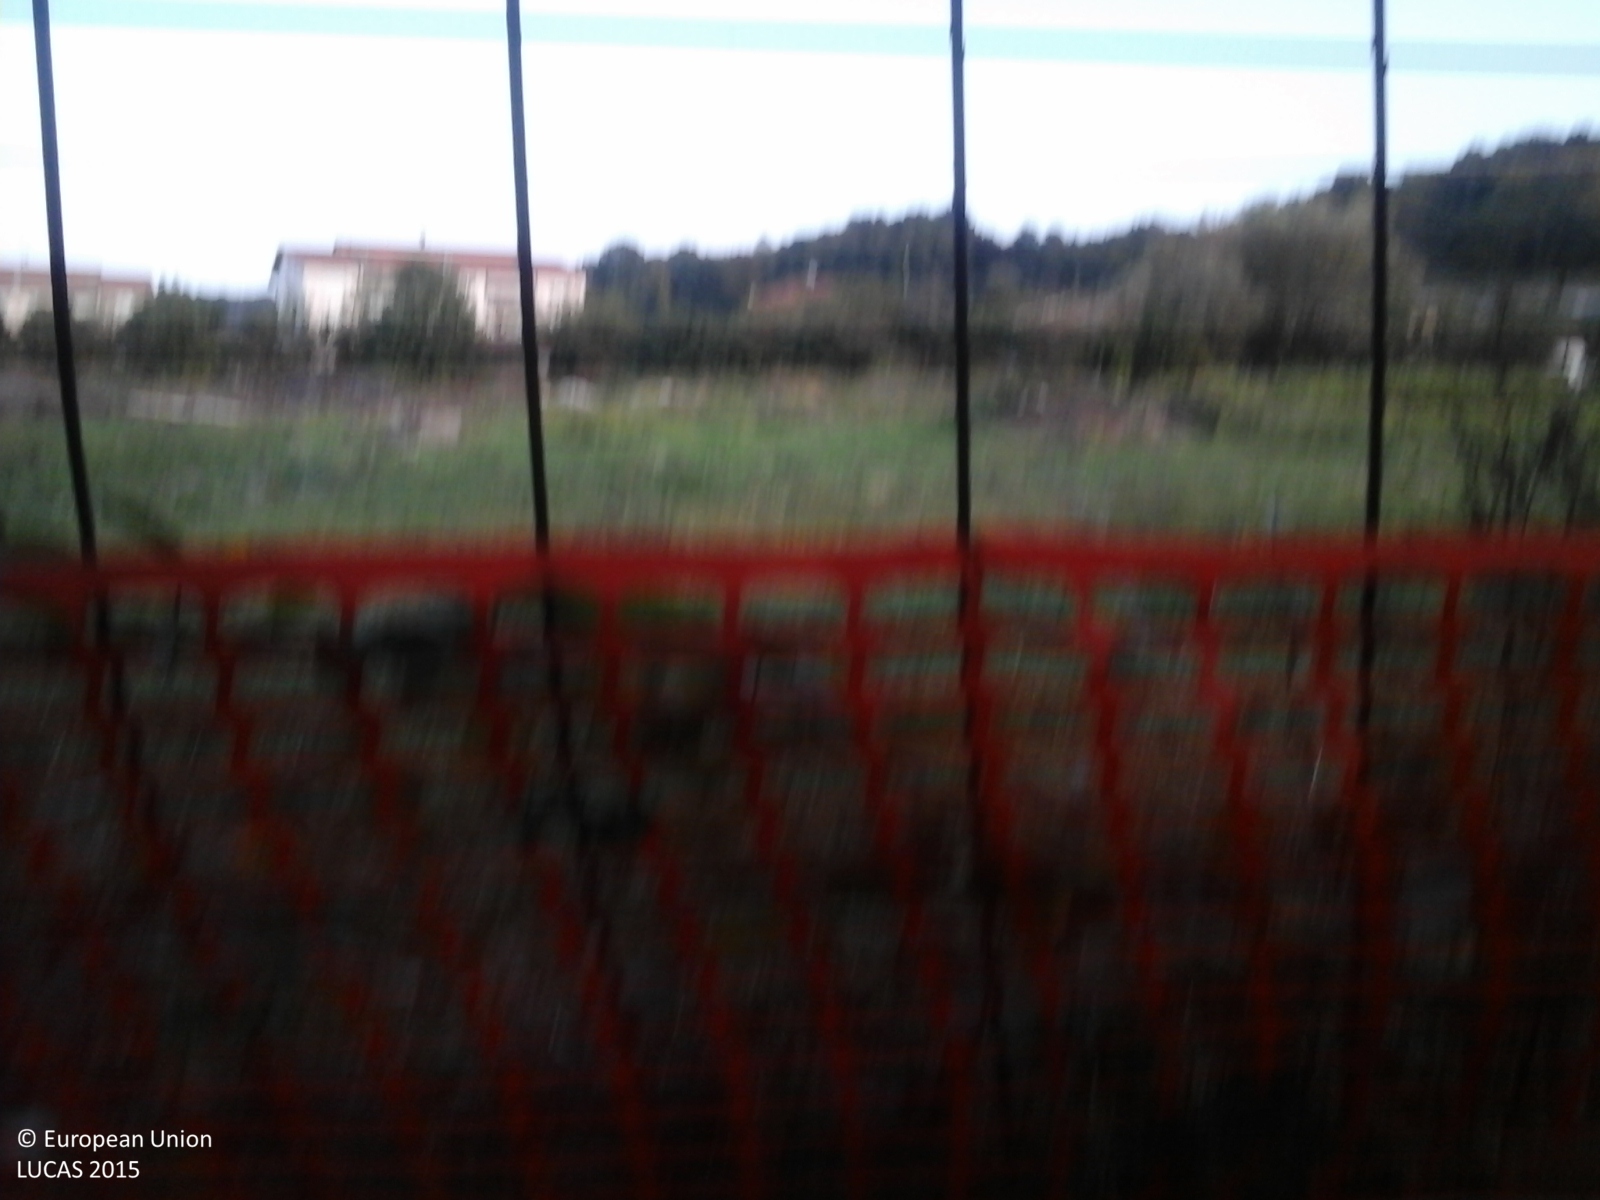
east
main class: Woodland
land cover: Broadleaved woodland
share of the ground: > 75 %
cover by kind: broadleaved forest trees 100 %
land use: Semi-natural and natural areas not in use
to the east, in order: Broadleaved woodland; Fences; Grassland without tree/shrub cover; Electric lines; Grassland without tree/shrub cover; Artificial constructions in urban areas
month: September
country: IT
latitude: 44.3544
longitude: 8.2850
